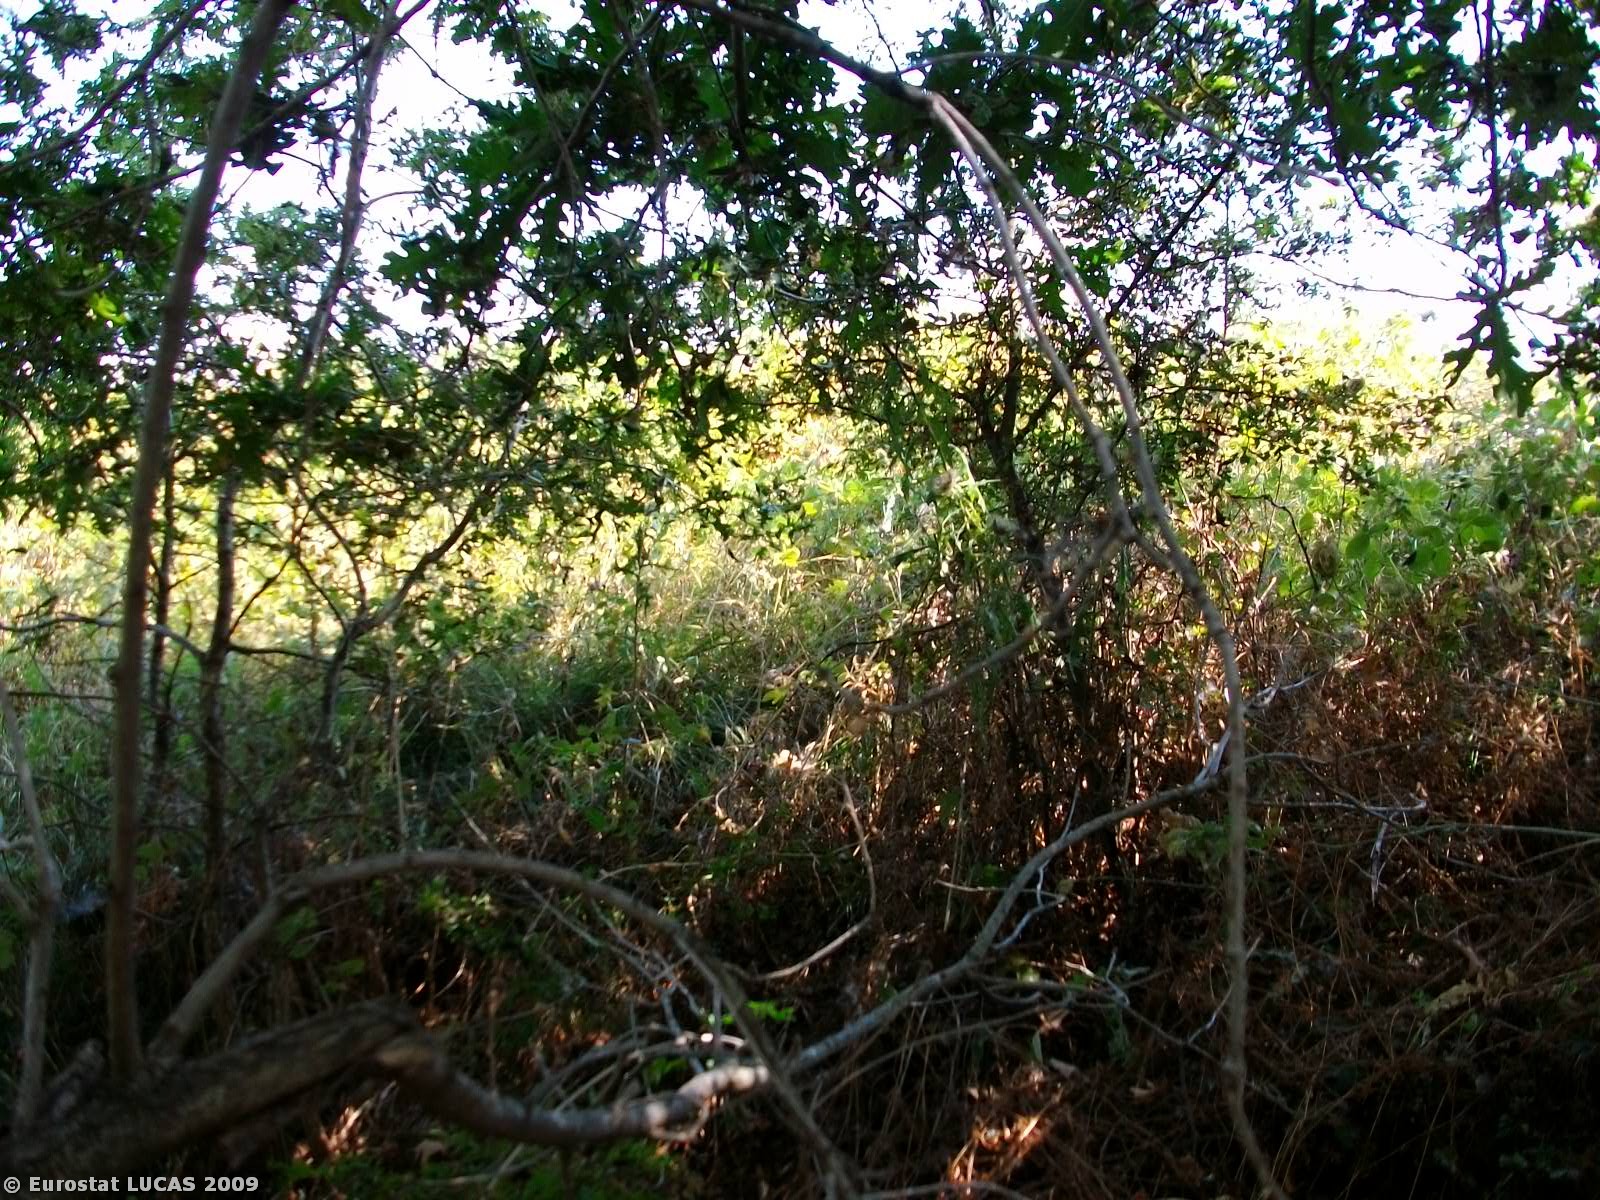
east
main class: Woodland
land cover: Broadleaved woodland
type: broadleaved evergreen forest
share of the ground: > 75 %
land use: Forestry
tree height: > 5 m
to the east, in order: Broadleaved woodland; Rivers and streams; Broadleaved woodland; Bare land; Durum wheat; Spontaneously vegetated surfaces
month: August
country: GR
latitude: 38.6812
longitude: 22.4736
